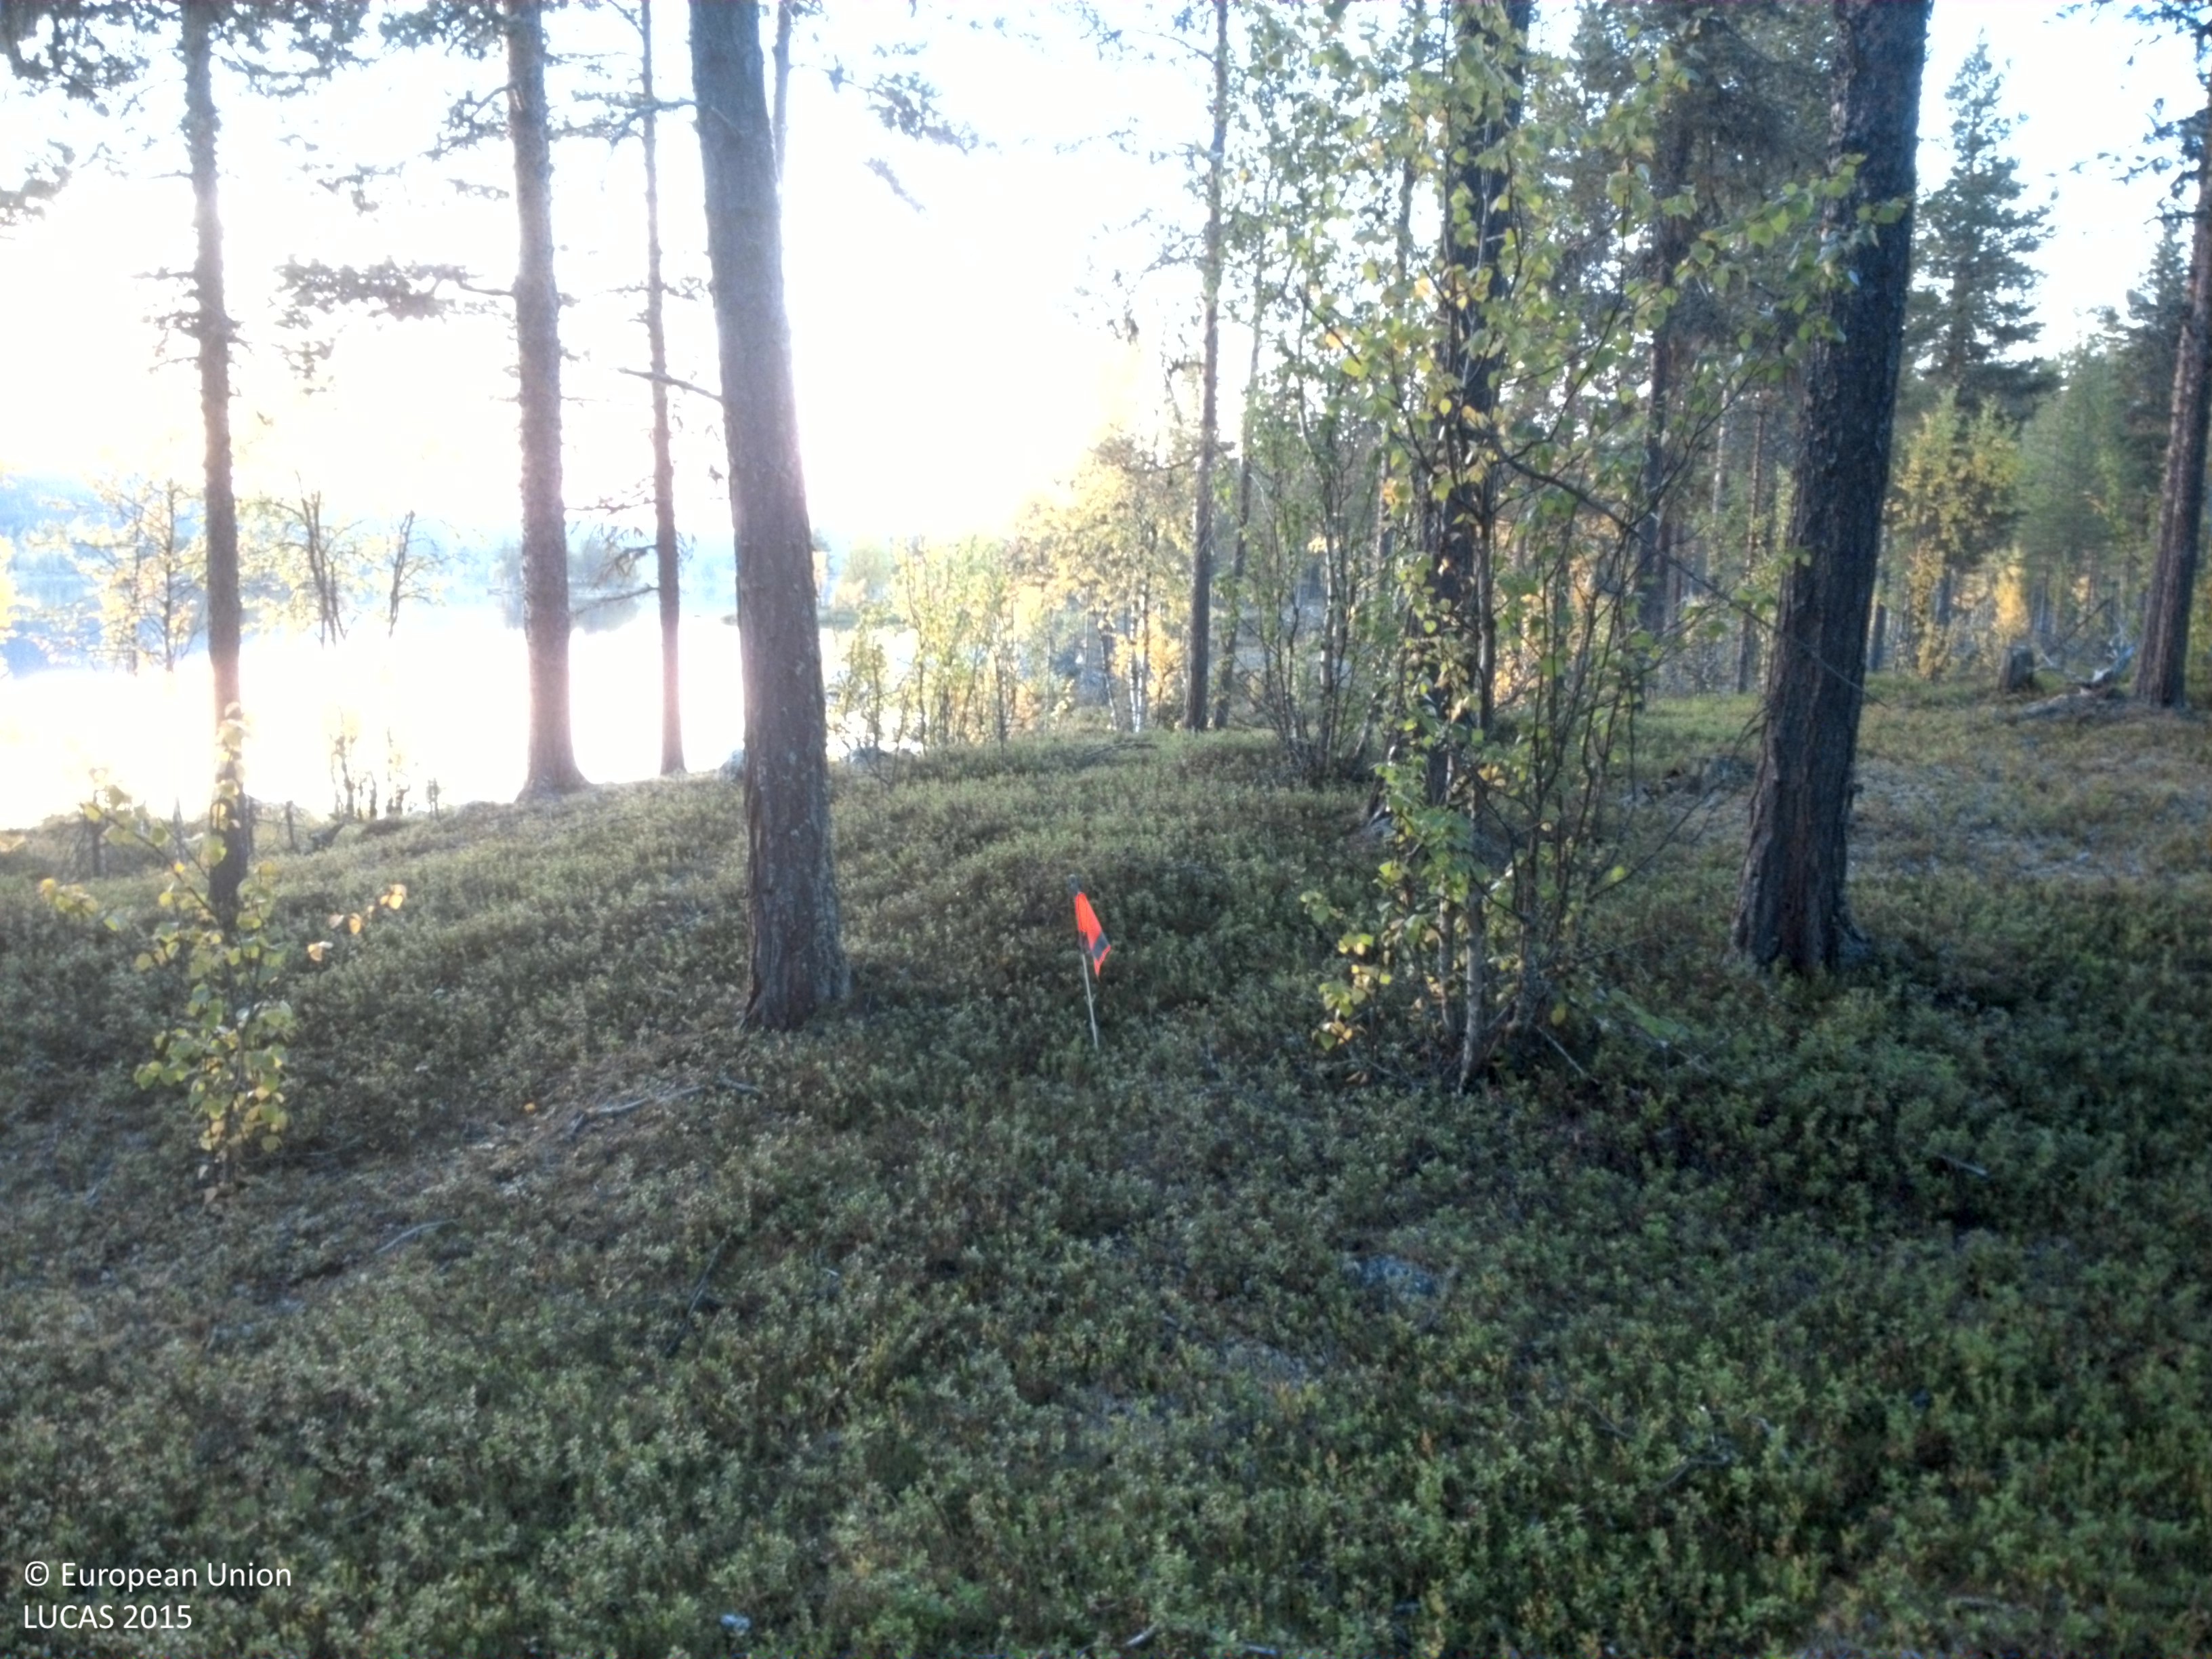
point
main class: Woodland
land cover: Pine dominated mixed woodland
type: boreal forest
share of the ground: 25 - 50 %
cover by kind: shrubs 45 %, broadleaved forest trees 30 %, lichens and mosses 15 %, coniferous forest trees 10 %
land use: Forestry
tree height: > 5 m
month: September
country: SE
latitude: 65.3293
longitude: 16.6398
